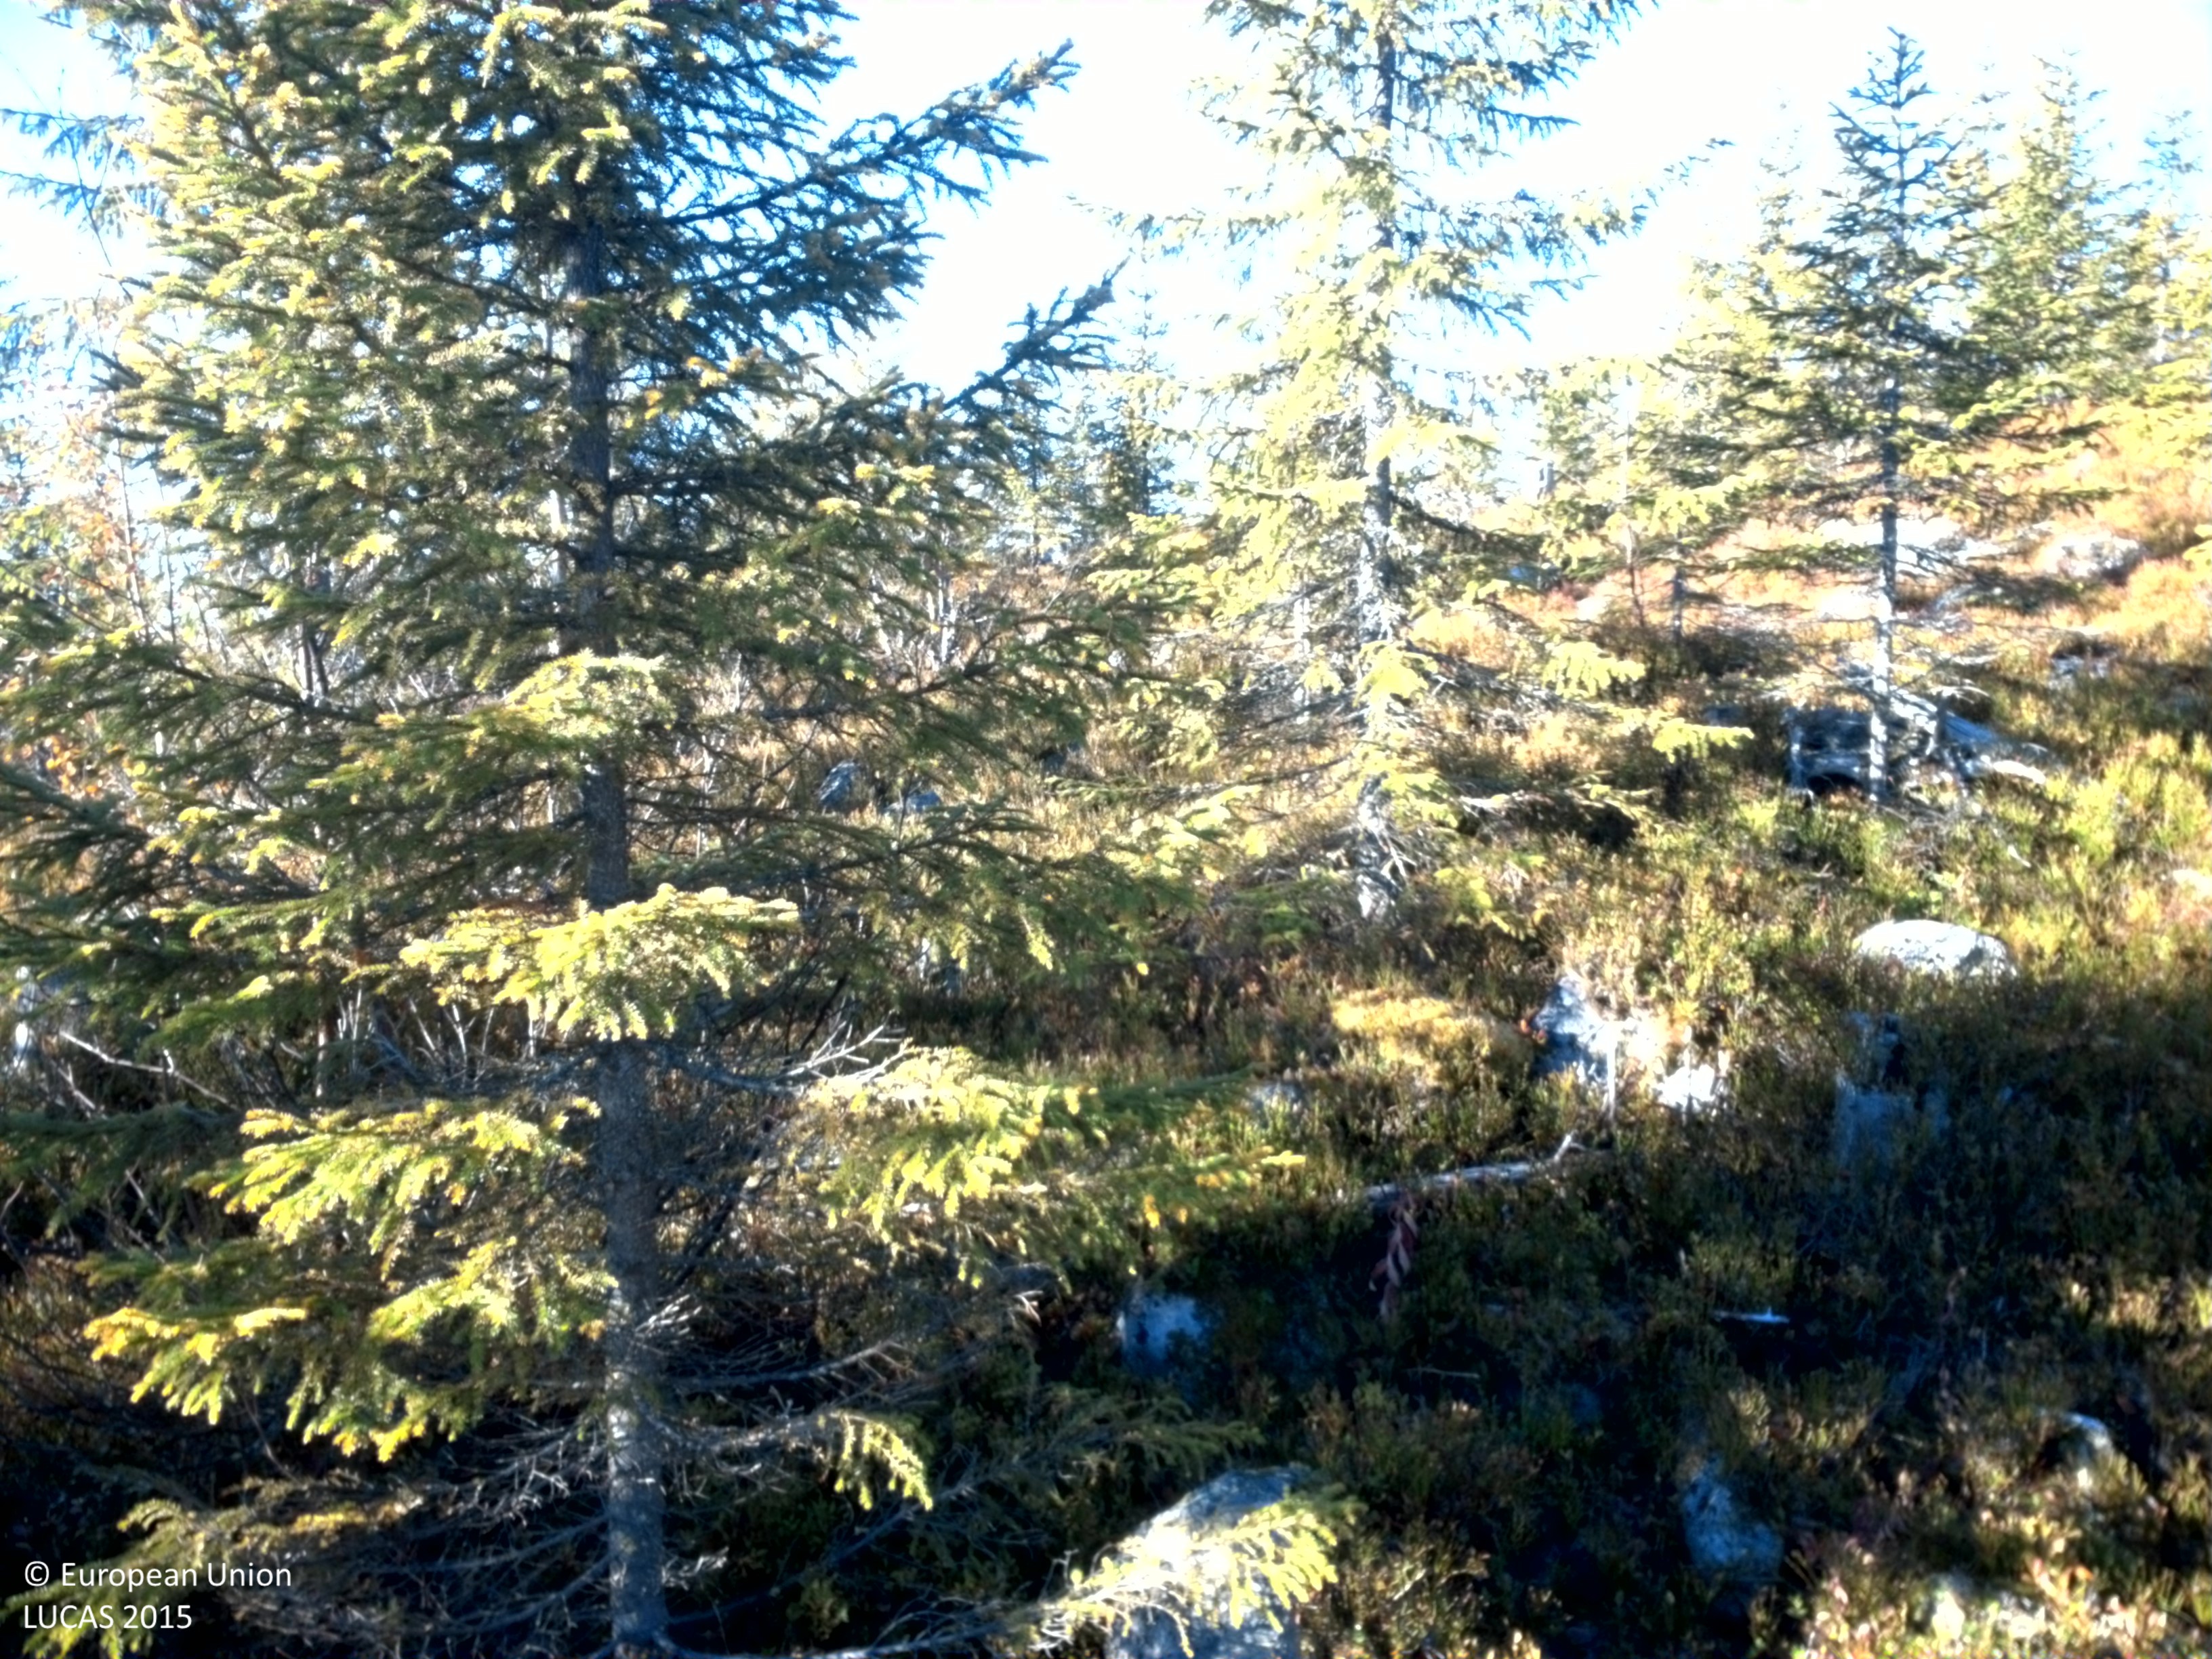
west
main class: Woodland
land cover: Spruce dominated coniferous woodland
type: boreal forest
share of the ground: 10 - 25 %
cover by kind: shrubs 65 %, coniferous forest trees 15 %, herbaceous plants 10 %, lichens and mosses 10 %
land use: Forestry
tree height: < 5 m
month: October
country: SE
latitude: 64.8645
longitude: 16.9068
